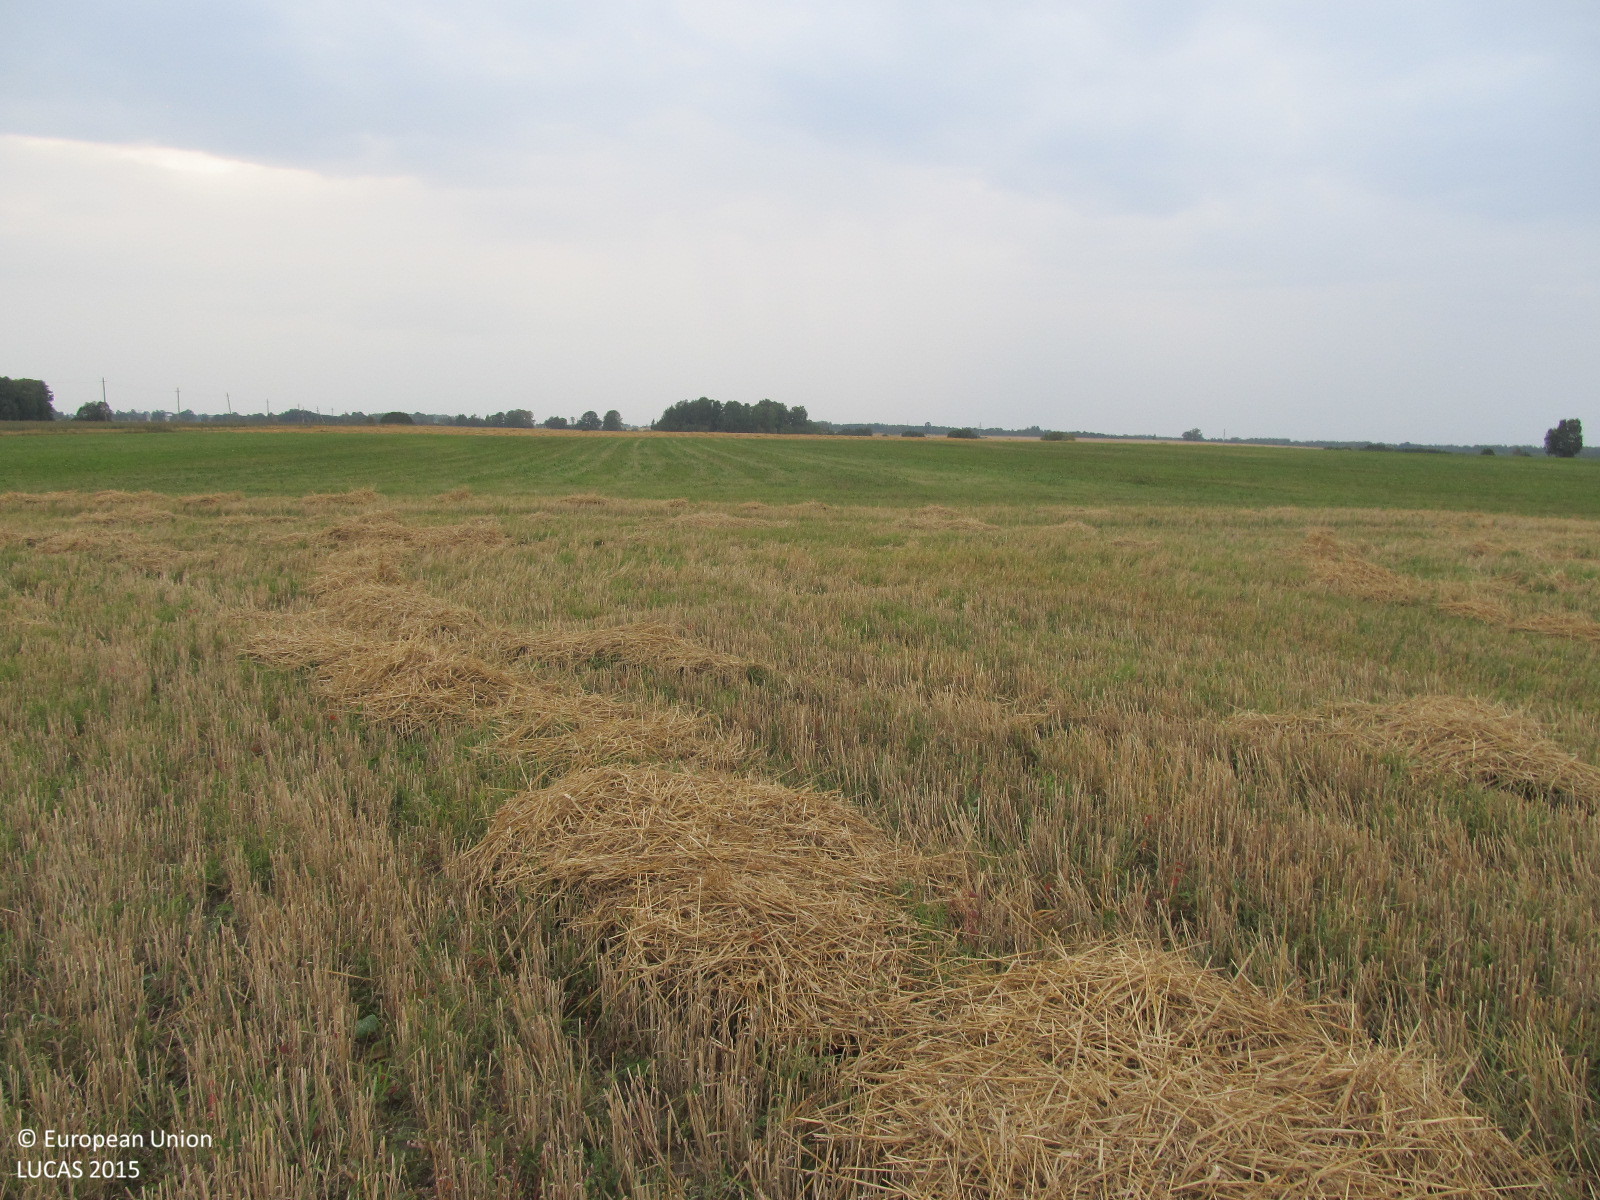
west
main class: Cropland
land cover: Common wheat
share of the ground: > 75 %
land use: Agriculture (excluding fallow land and kitchen gardens)
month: August
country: LT
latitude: 55.6275
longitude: 23.0457
